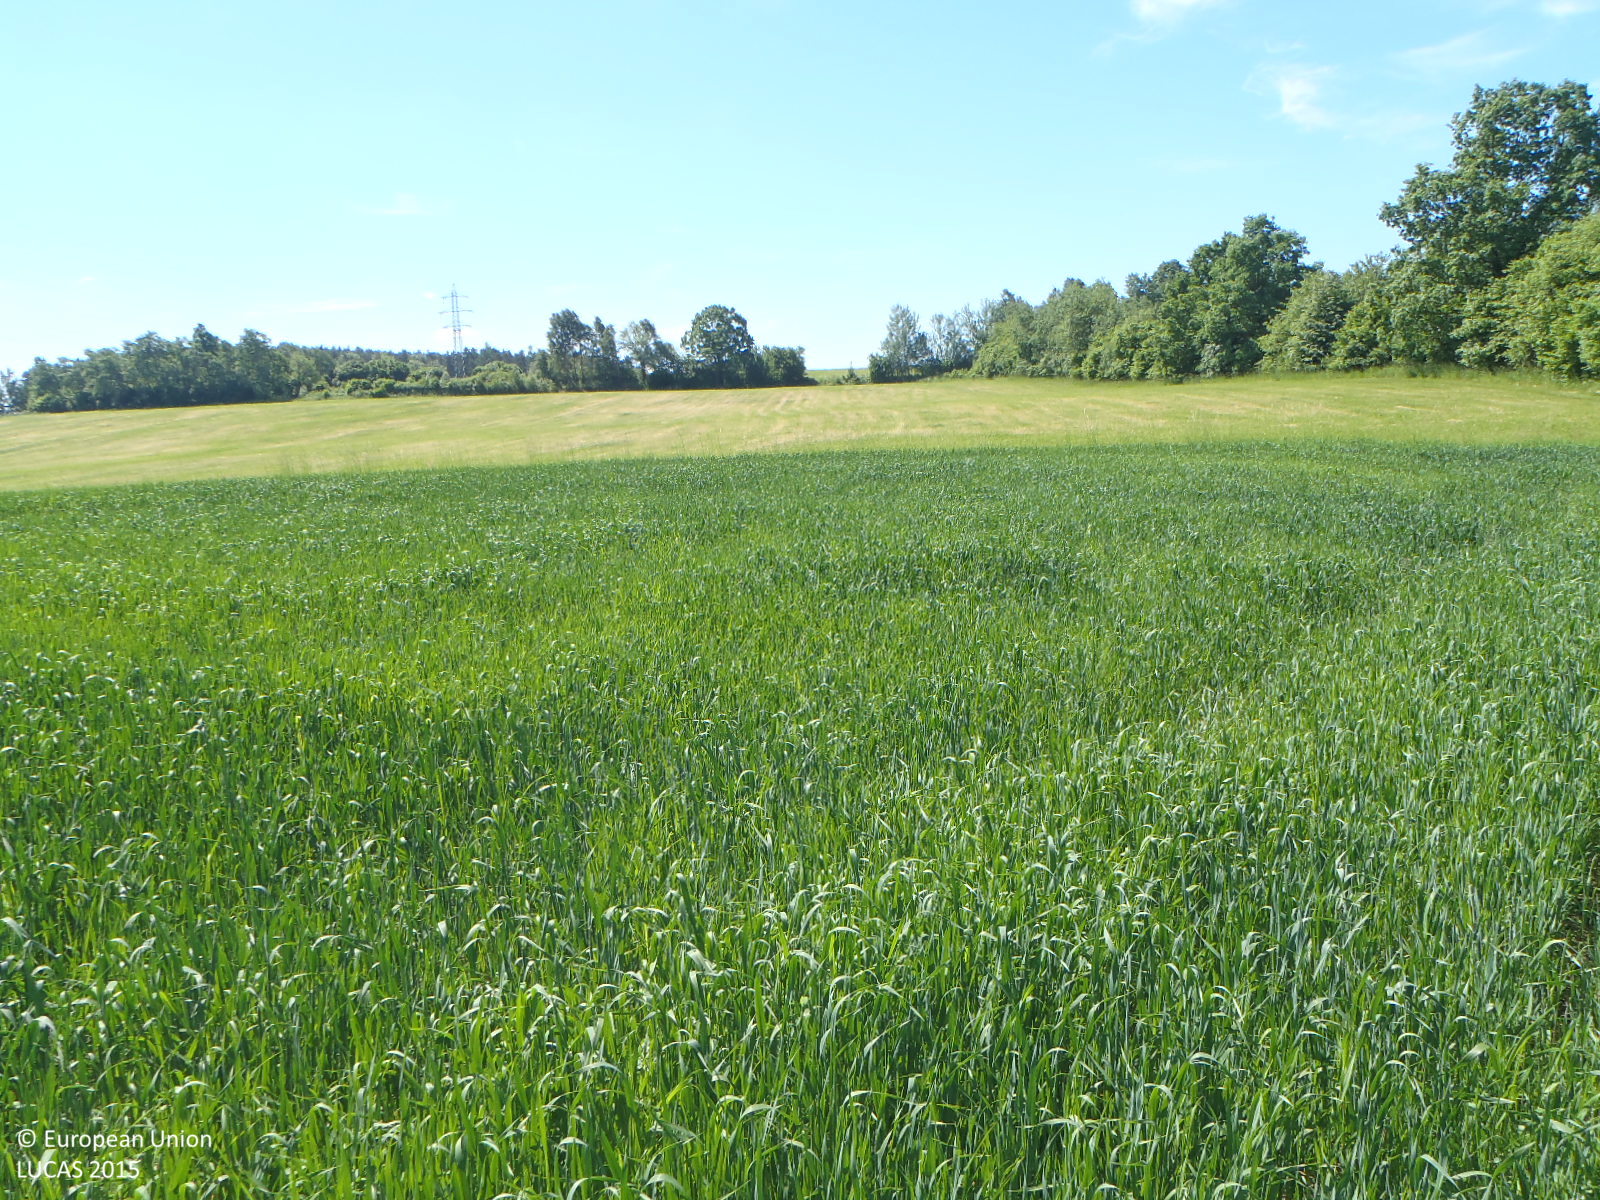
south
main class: Cropland
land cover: Oats
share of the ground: > 75 %
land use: Agriculture (excluding fallow land and kitchen gardens)
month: June
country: CZ
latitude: 48.8933
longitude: 14.3792
